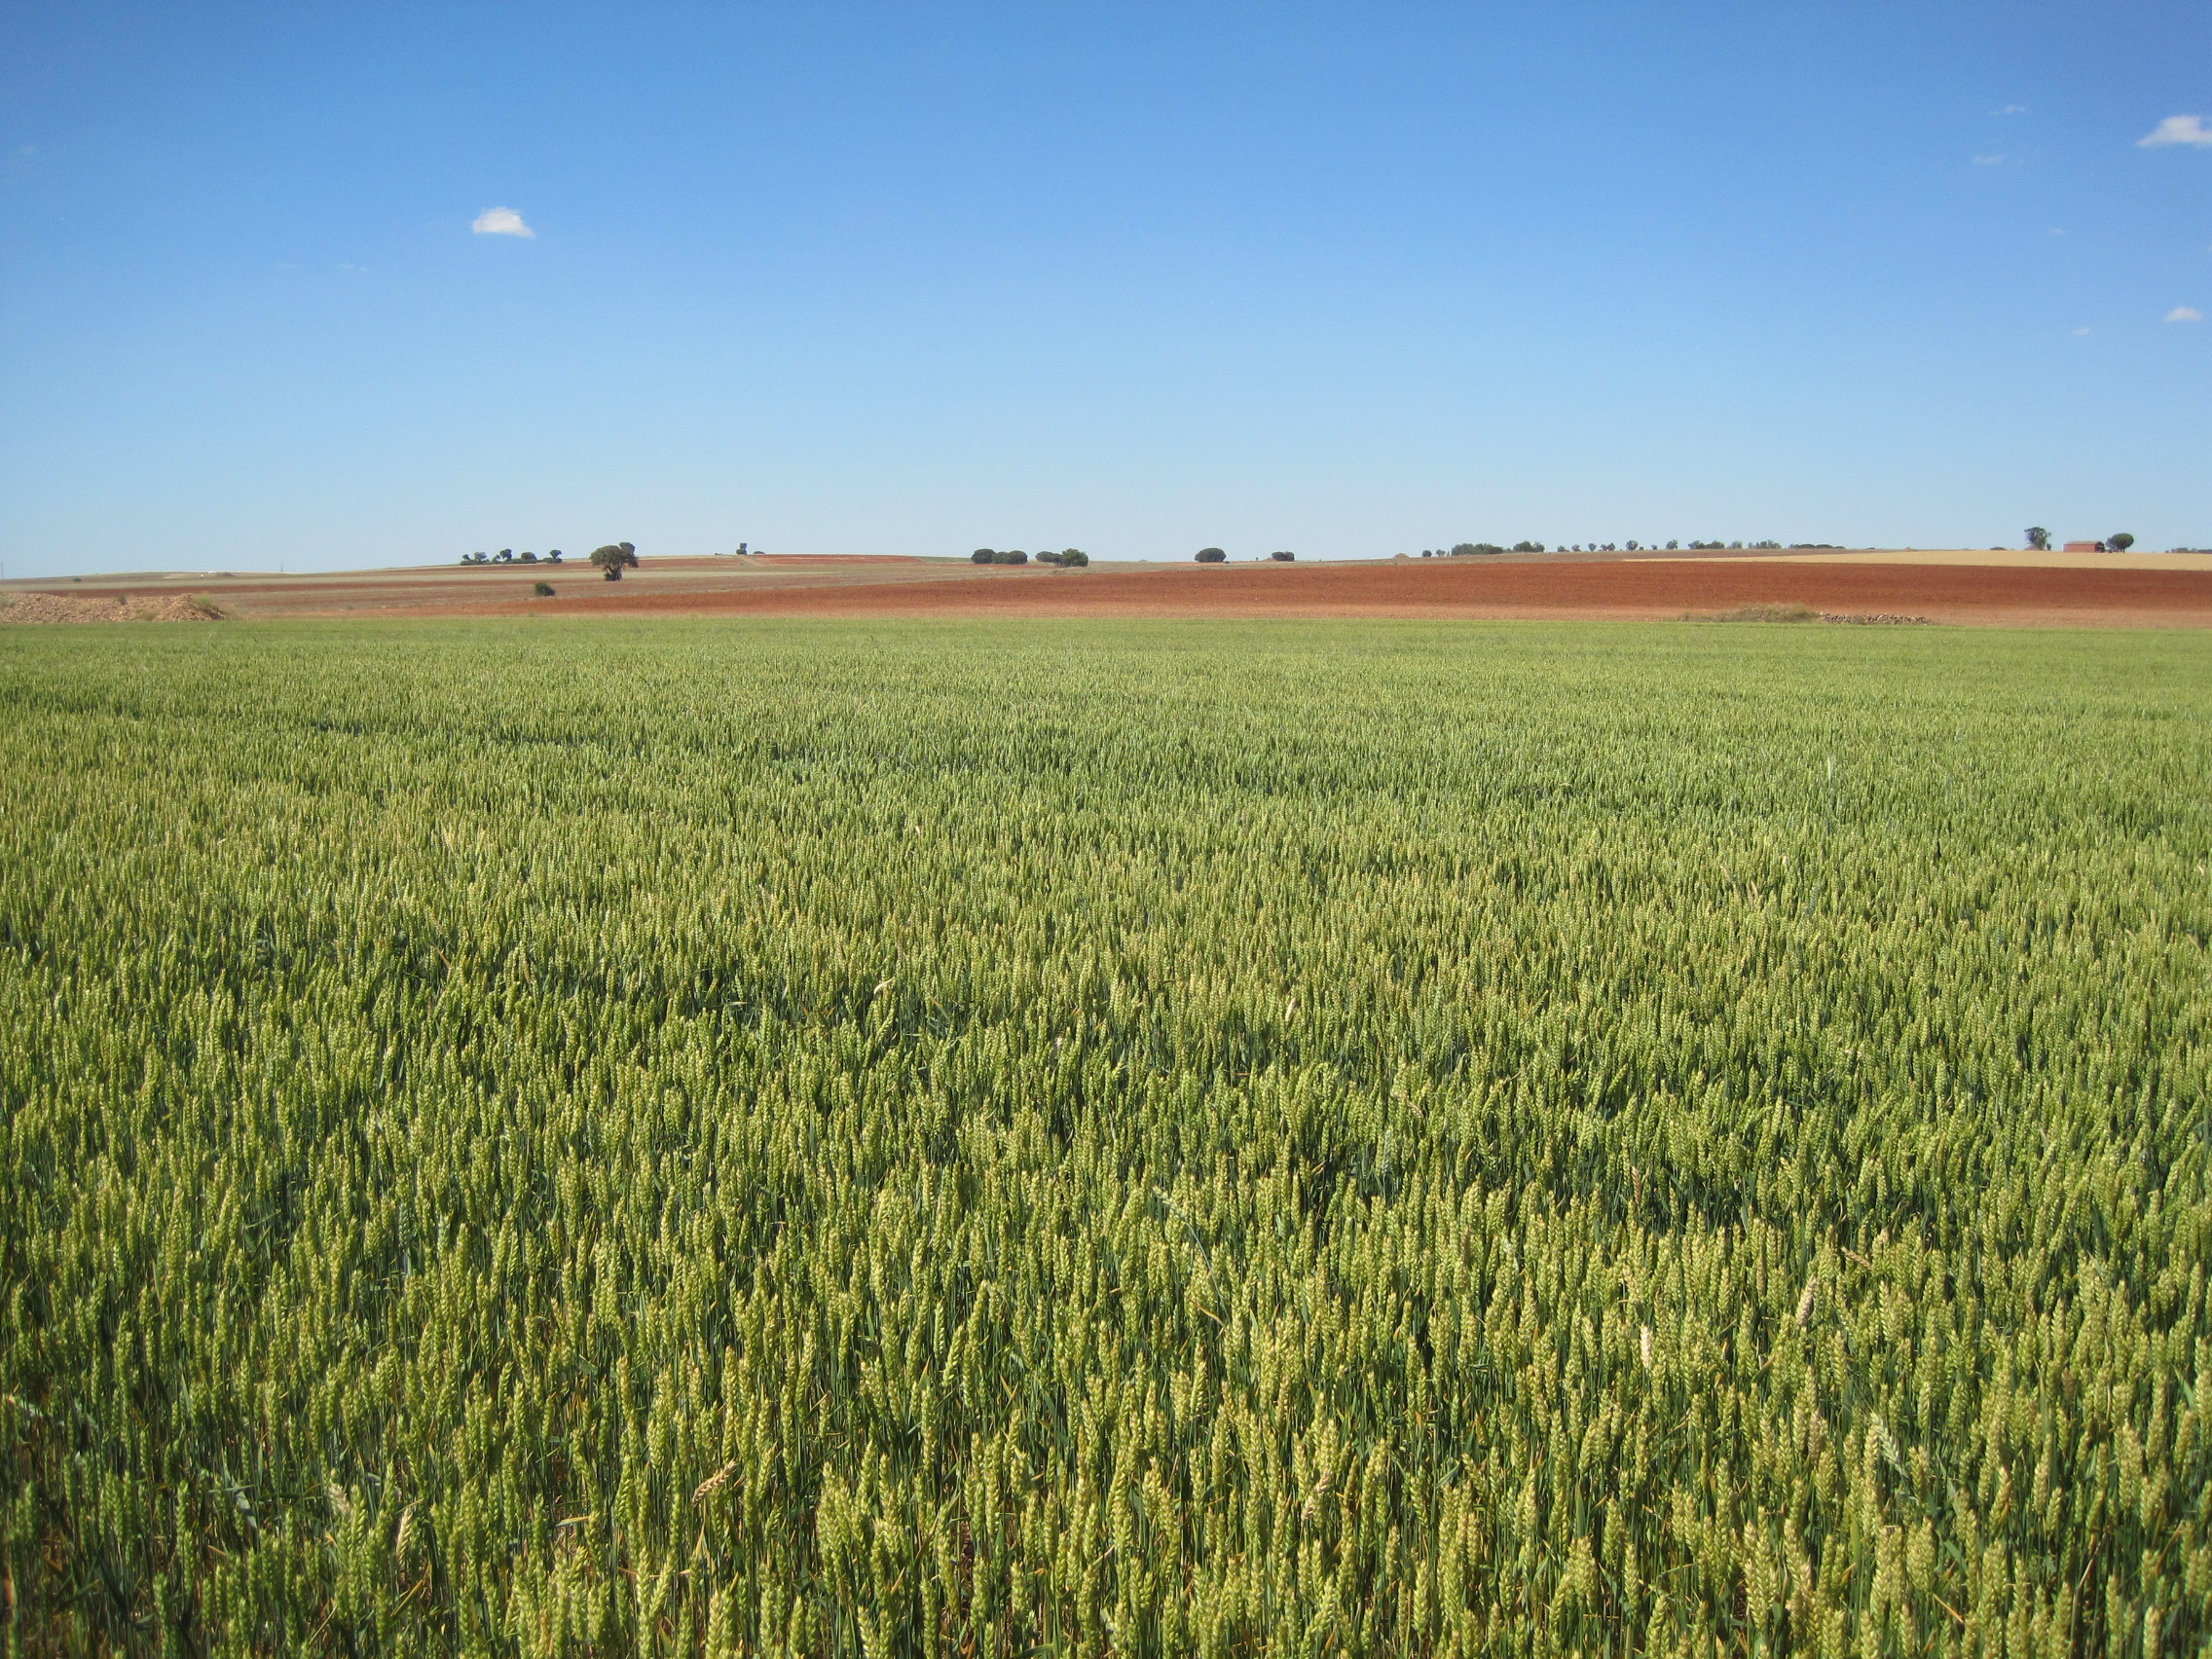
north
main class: Cropland
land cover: Common wheat
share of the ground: > 75 %
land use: Agriculture (excluding fallow land and kitchen gardens)
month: June
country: ES
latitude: 41.7662
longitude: -5.3712
